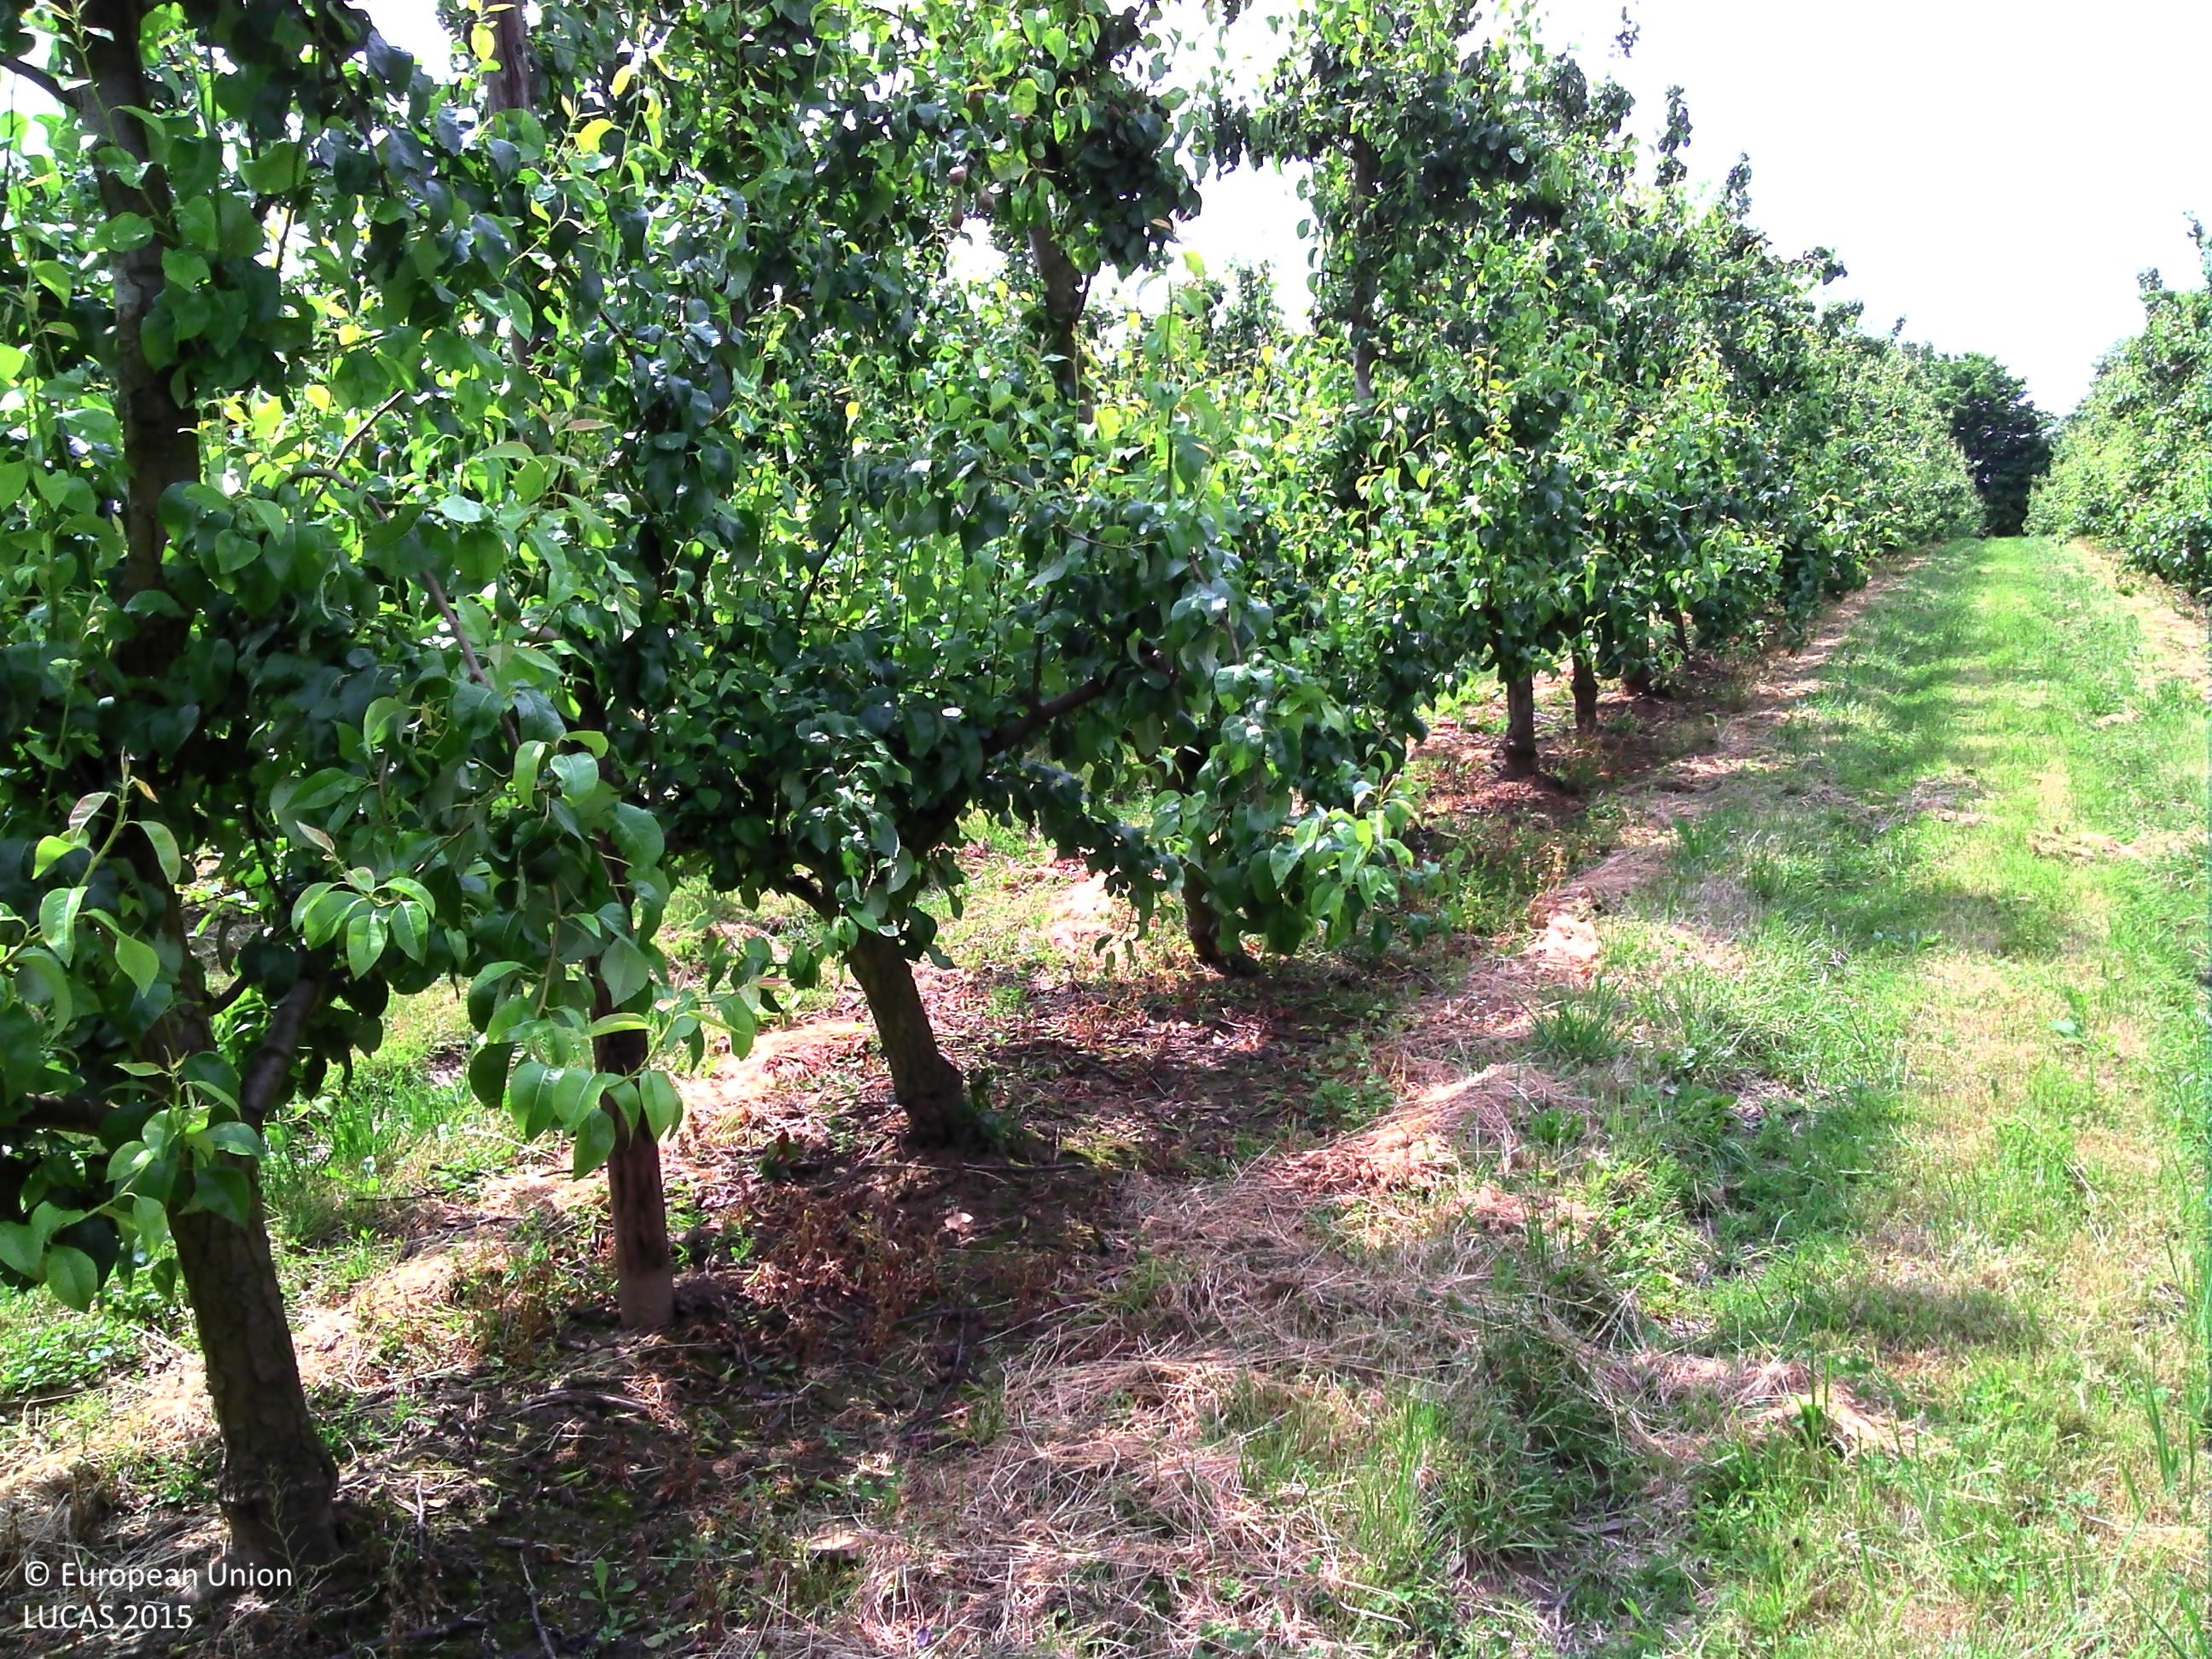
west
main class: Cropland
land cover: Pear fruit
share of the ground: 50 - 75 %
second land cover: Grassland without tree/shrub cover
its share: 25 - 50 %
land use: Agriculture (excluding fallow land and kitchen gardens)
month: June
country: BE
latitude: 50.7114
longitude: 5.5940
